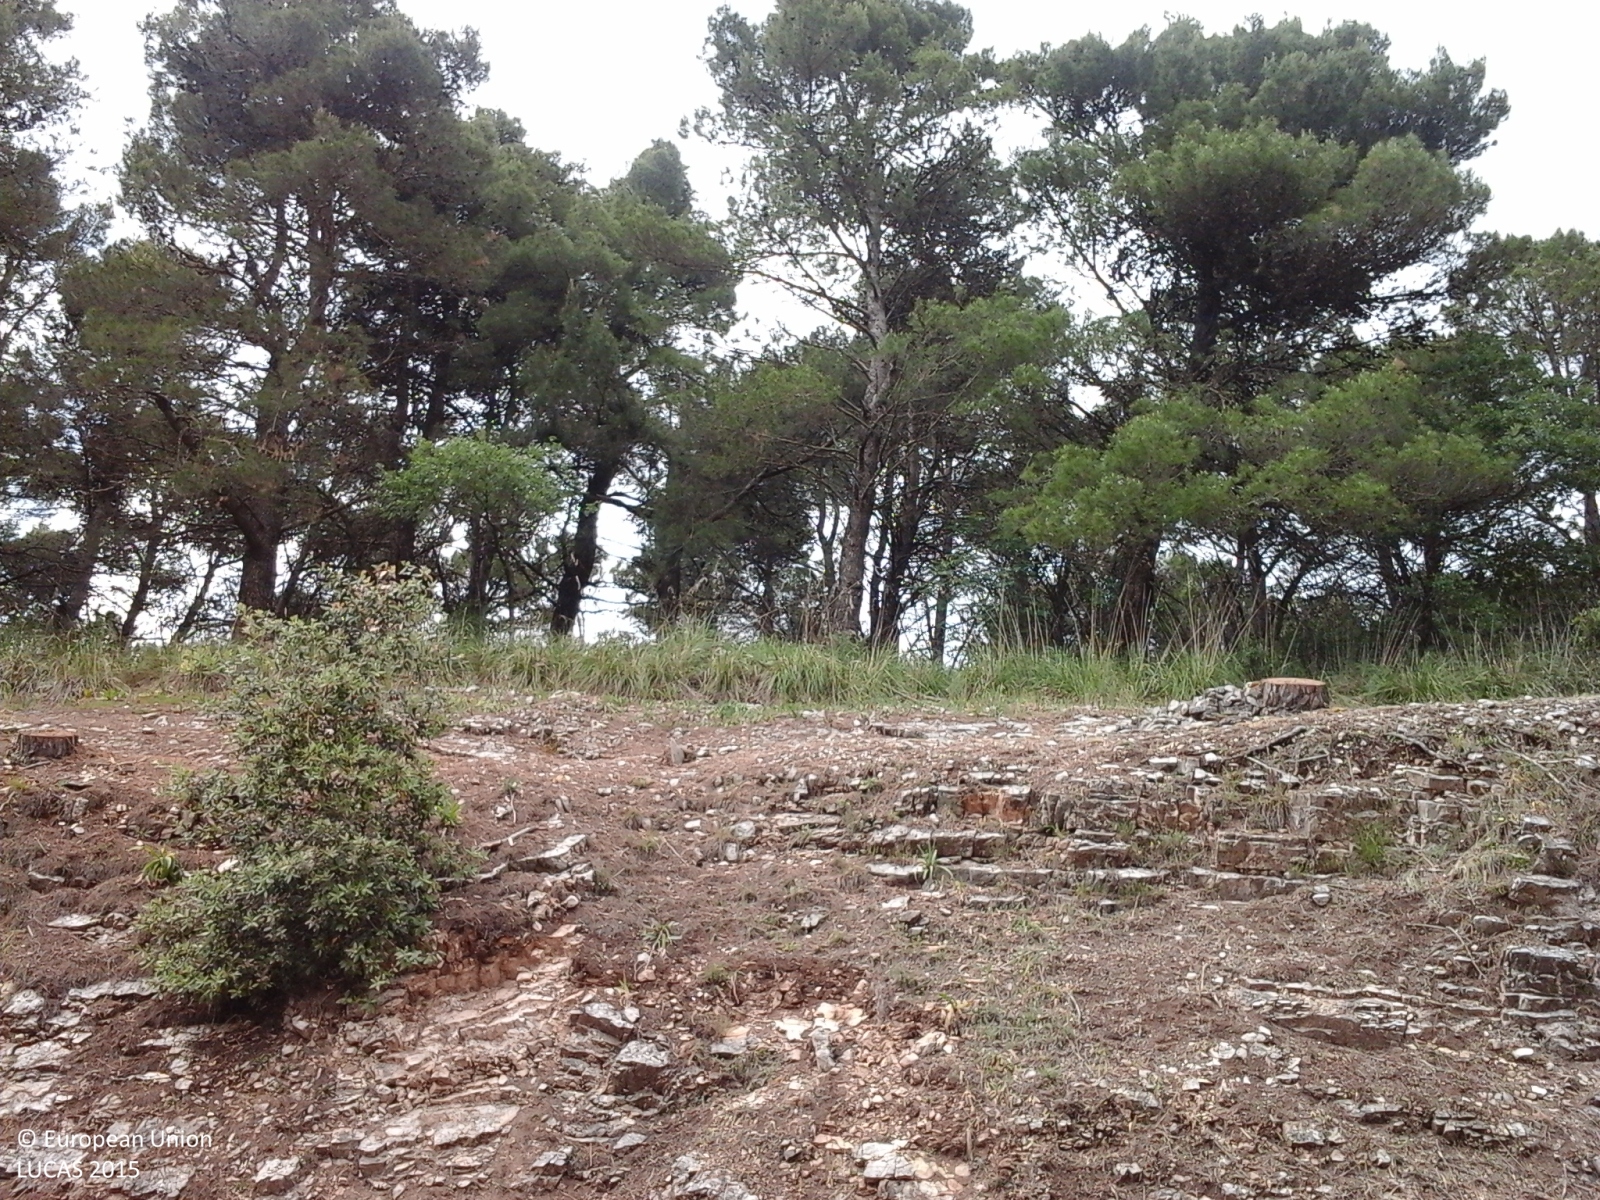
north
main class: Woodland
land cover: Pine dominated mixed woodland
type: coniferous forest of the mediterranean region
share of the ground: > 75 %
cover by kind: coniferous forest trees 50 %, broadleaved forest trees 30 %, shrubs 15 %, herbaceous plants 5 %
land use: Forestry
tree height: > 5 m
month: June
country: IT
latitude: 37.6089
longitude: 13.5418
